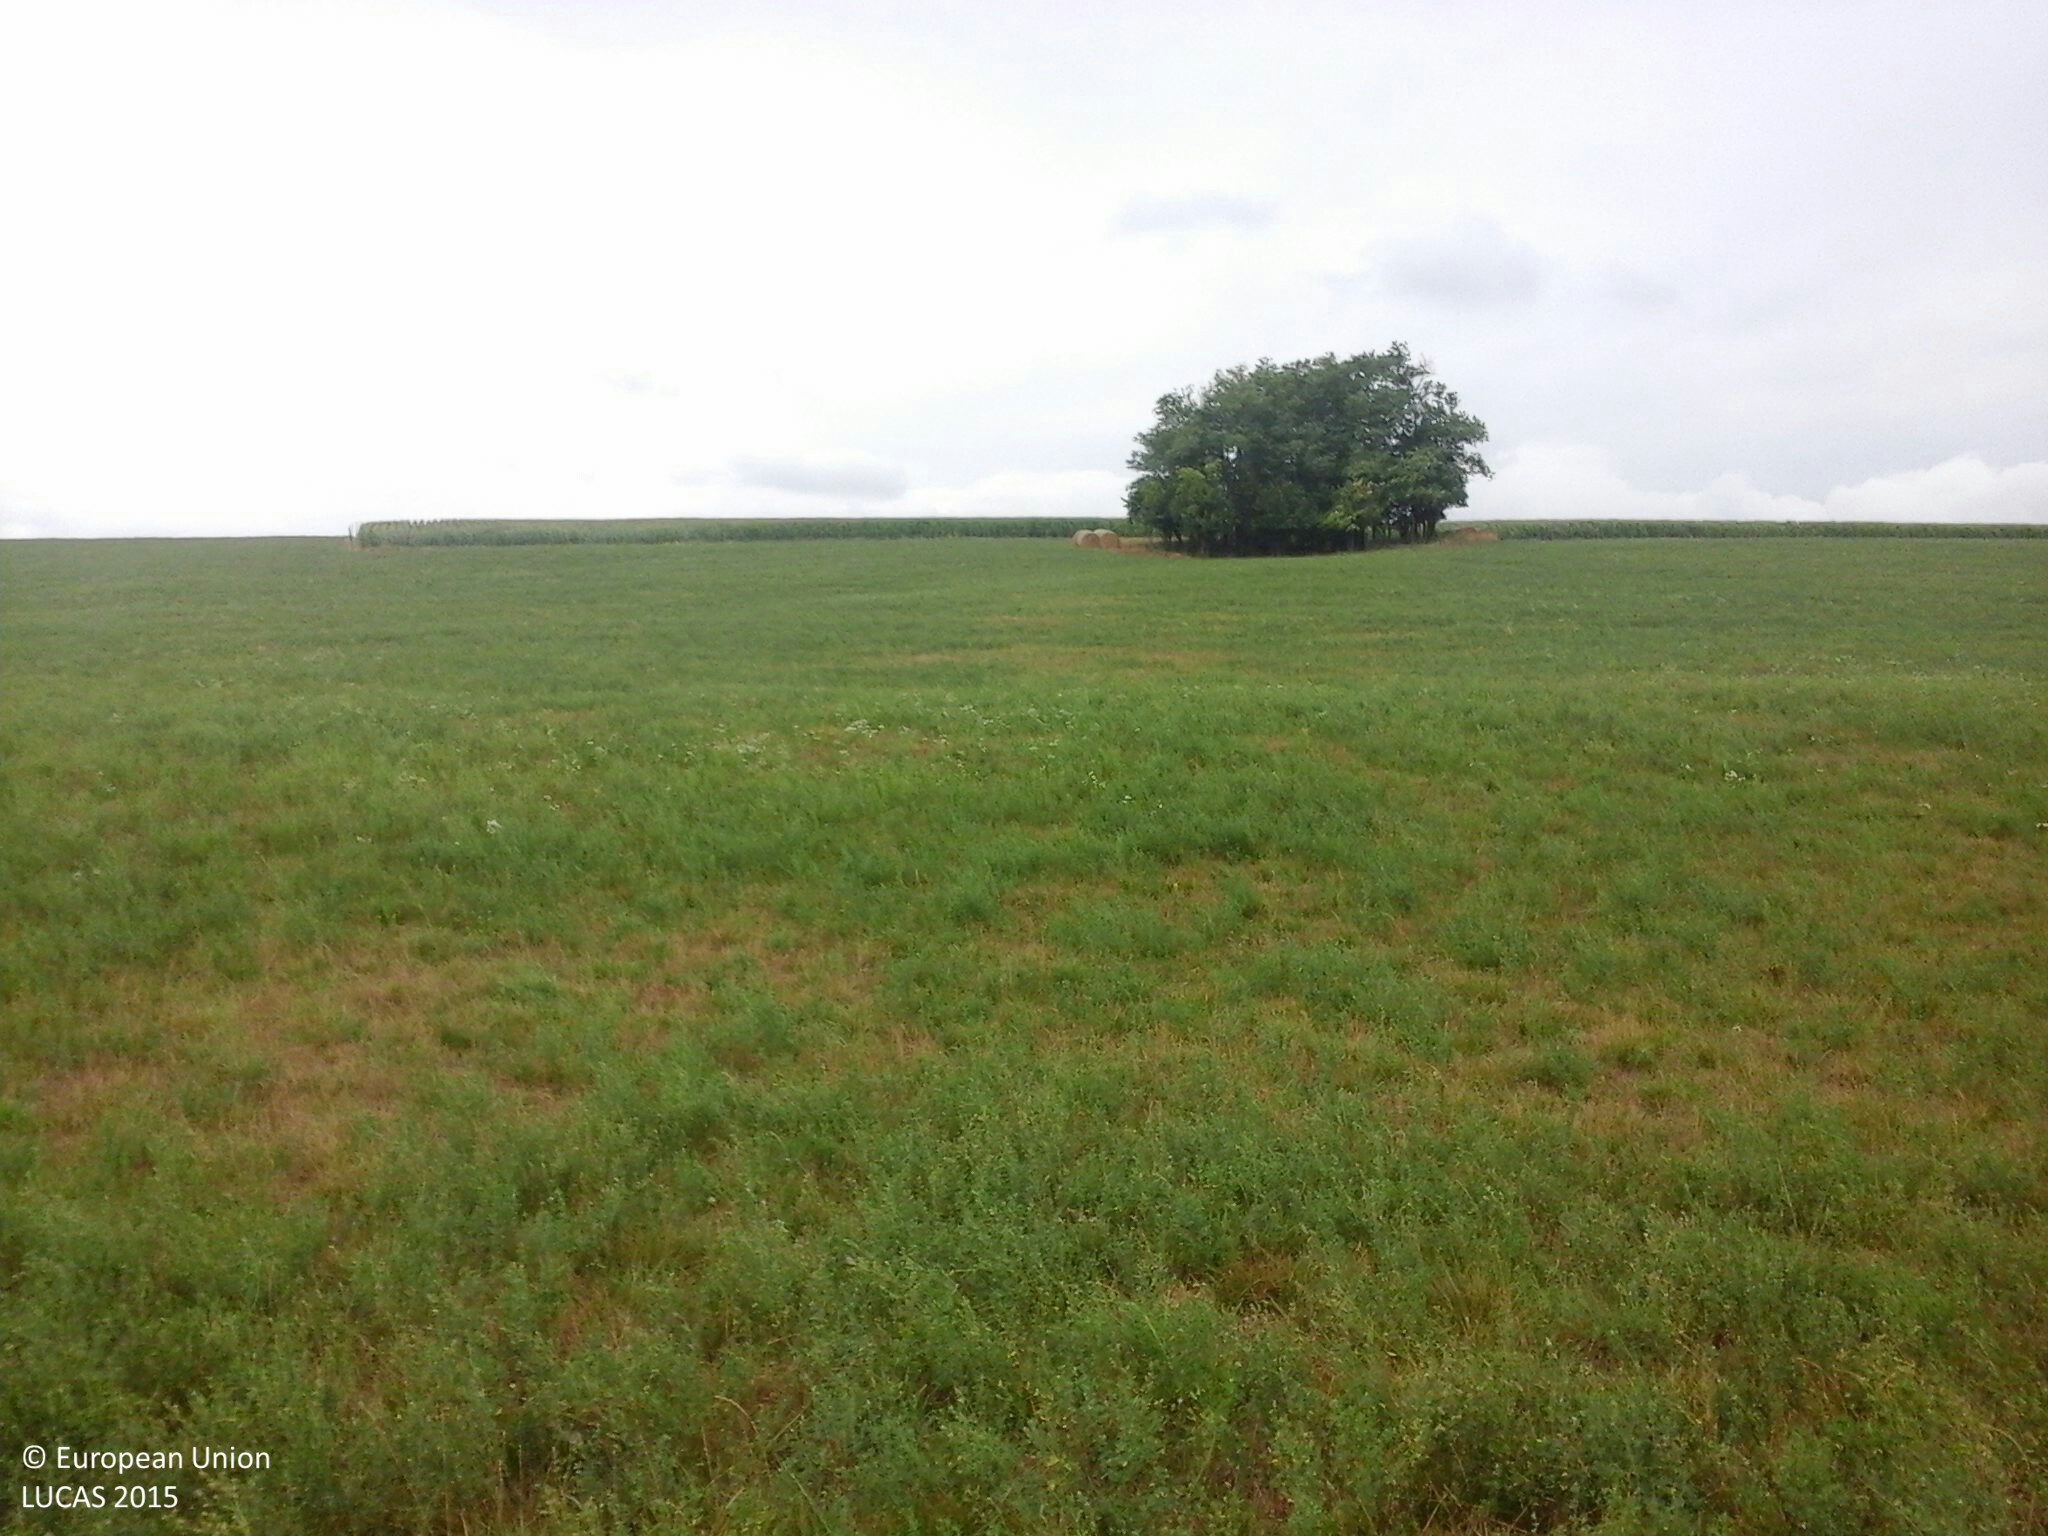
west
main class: Cropland
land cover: Lucerne
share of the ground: > 75 %
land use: Agriculture (excluding fallow land and kitchen gardens)
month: July
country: HU
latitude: 46.7641
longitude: 17.9033
